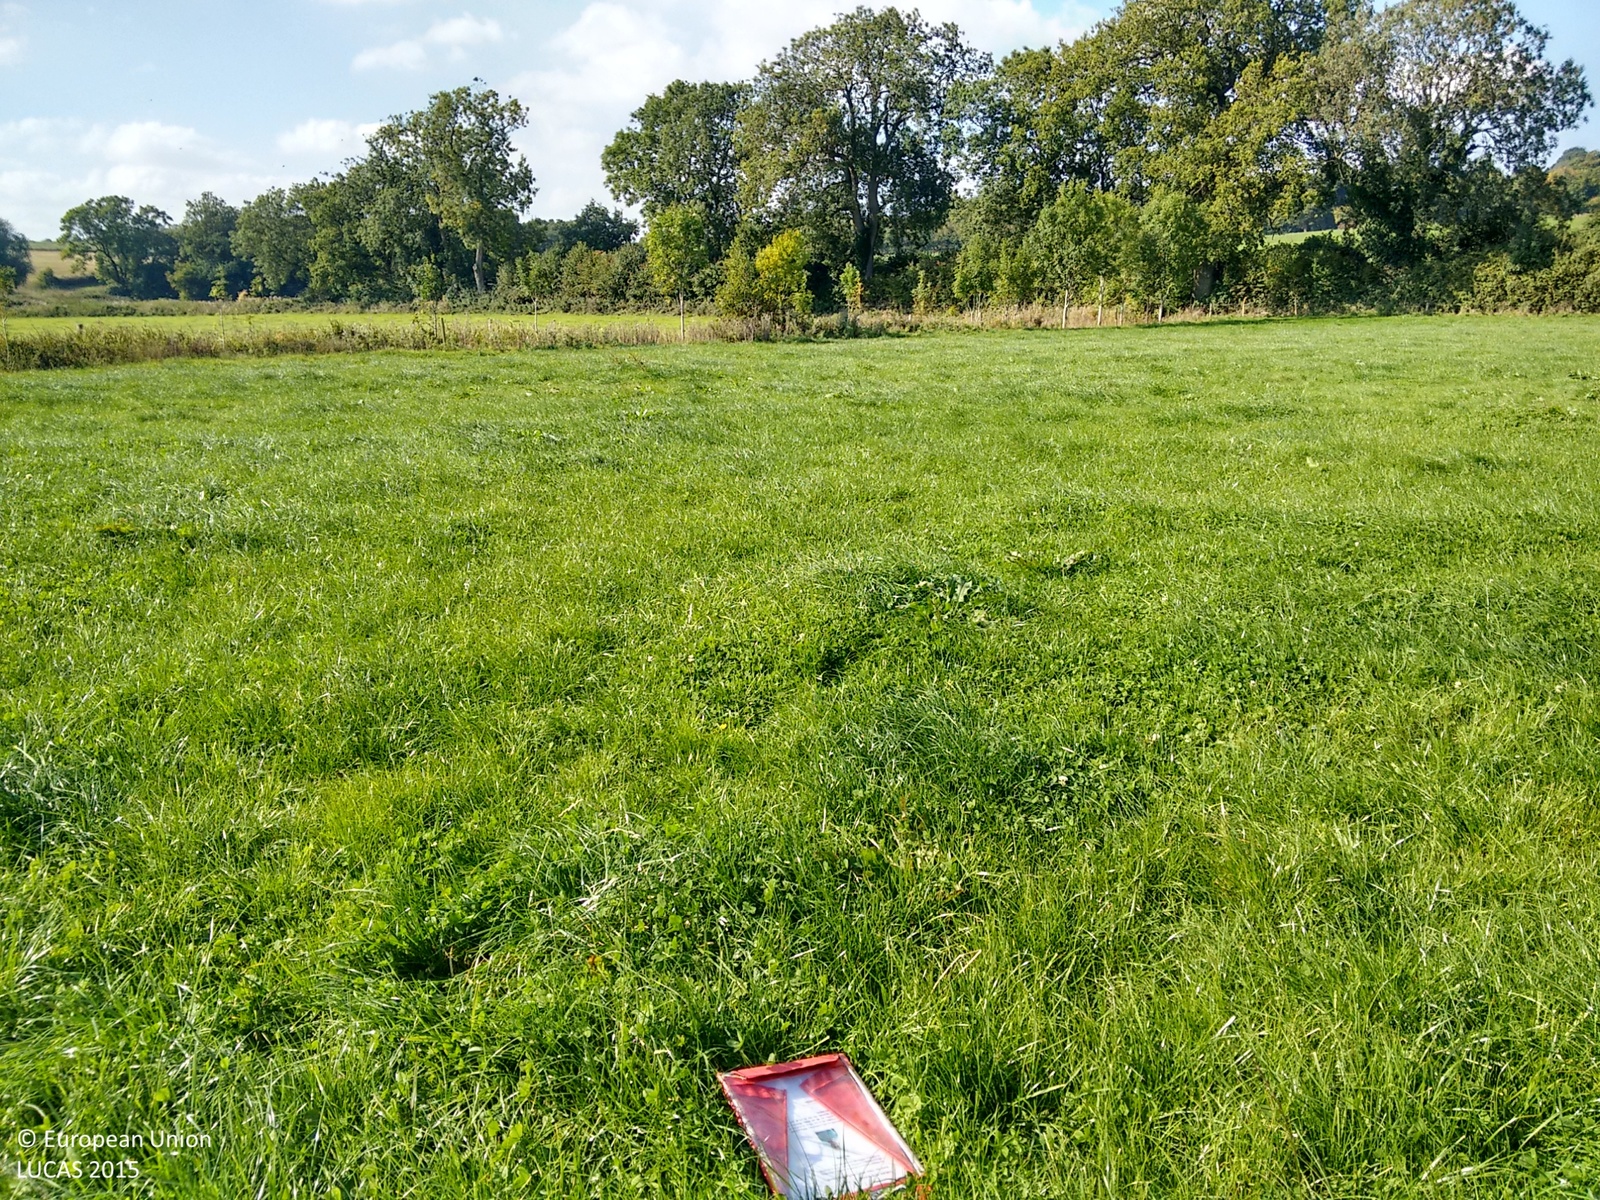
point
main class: Grassland
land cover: Grassland without tree/shrub cover
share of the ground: > 75 %
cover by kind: herbaceous plants 100 %
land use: Agriculture (excluding fallow land and kitchen gardens)
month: October
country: GB
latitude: 51.7075
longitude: -2.5563
